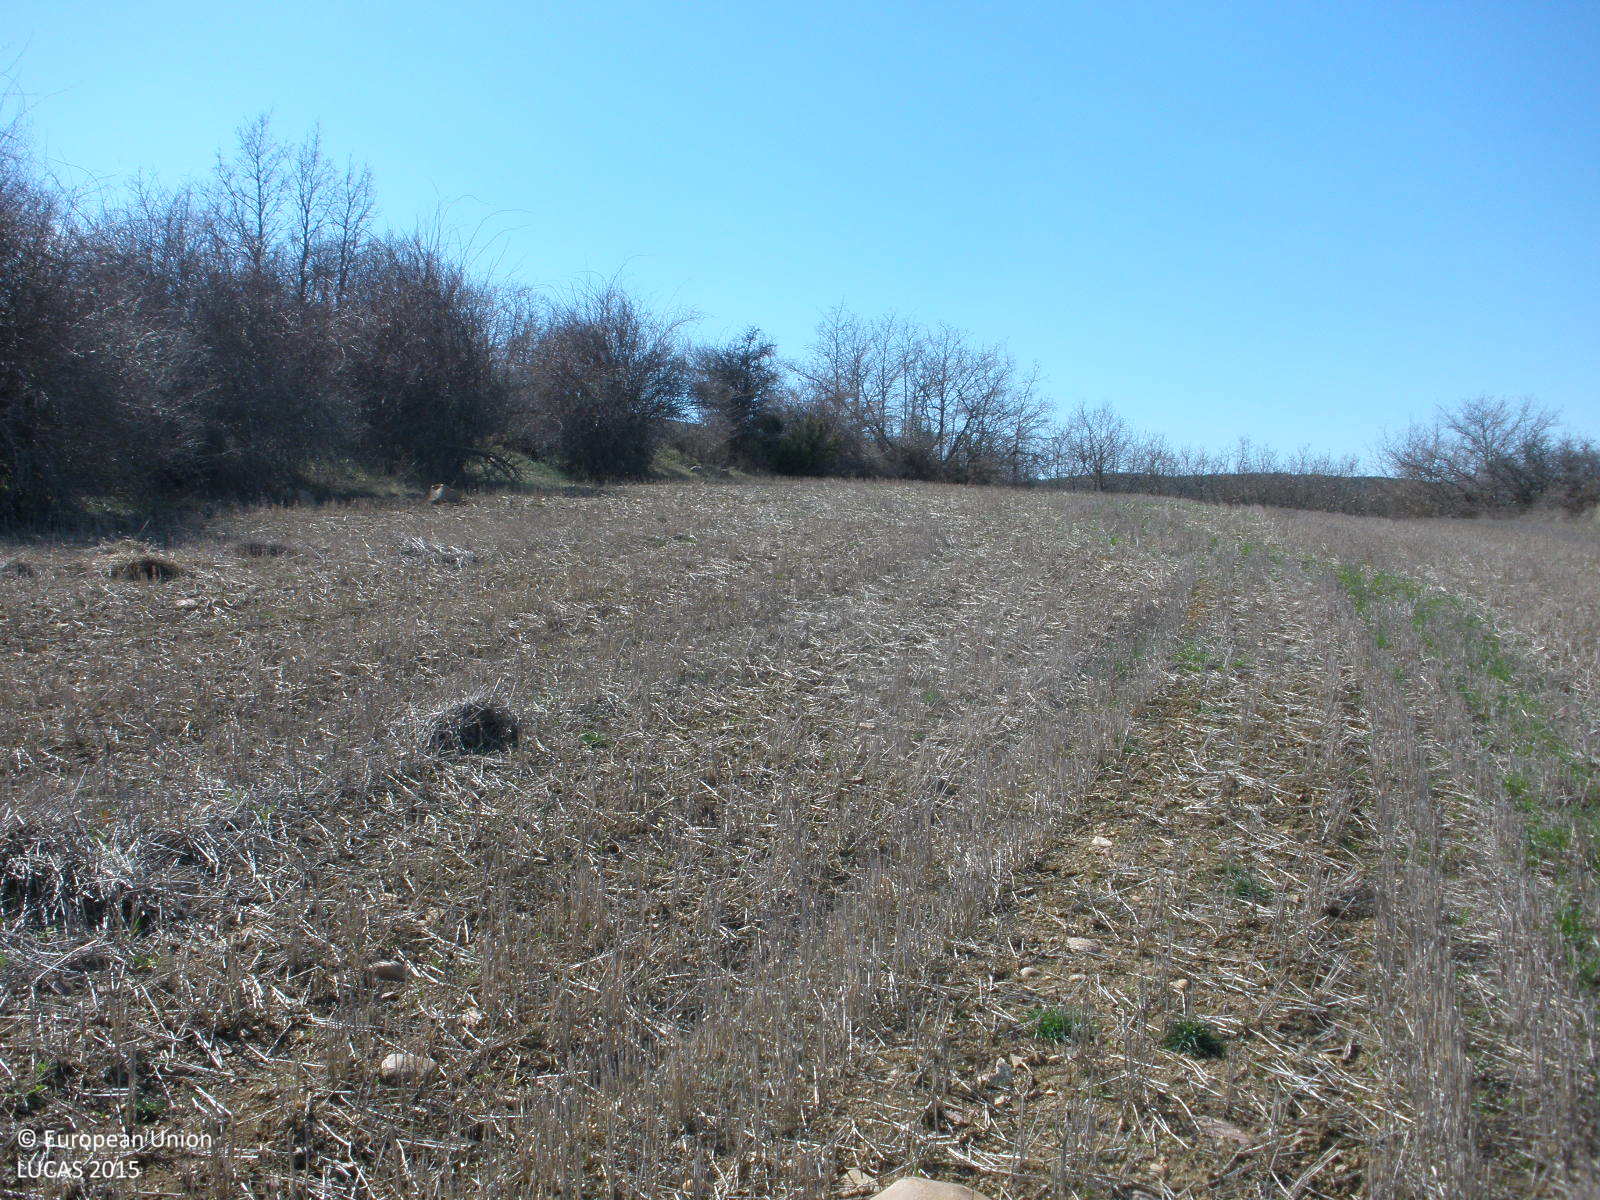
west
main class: Grassland
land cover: Spontaneously vegetated surfaces
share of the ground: 50 - 75 %
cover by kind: herbaceous plants 70 %, unconsolidated bare surface 30 %
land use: Agriculture (excluding fallow land and kitchen gardens)
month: April
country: ES
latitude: 40.9871
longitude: -1.0830
